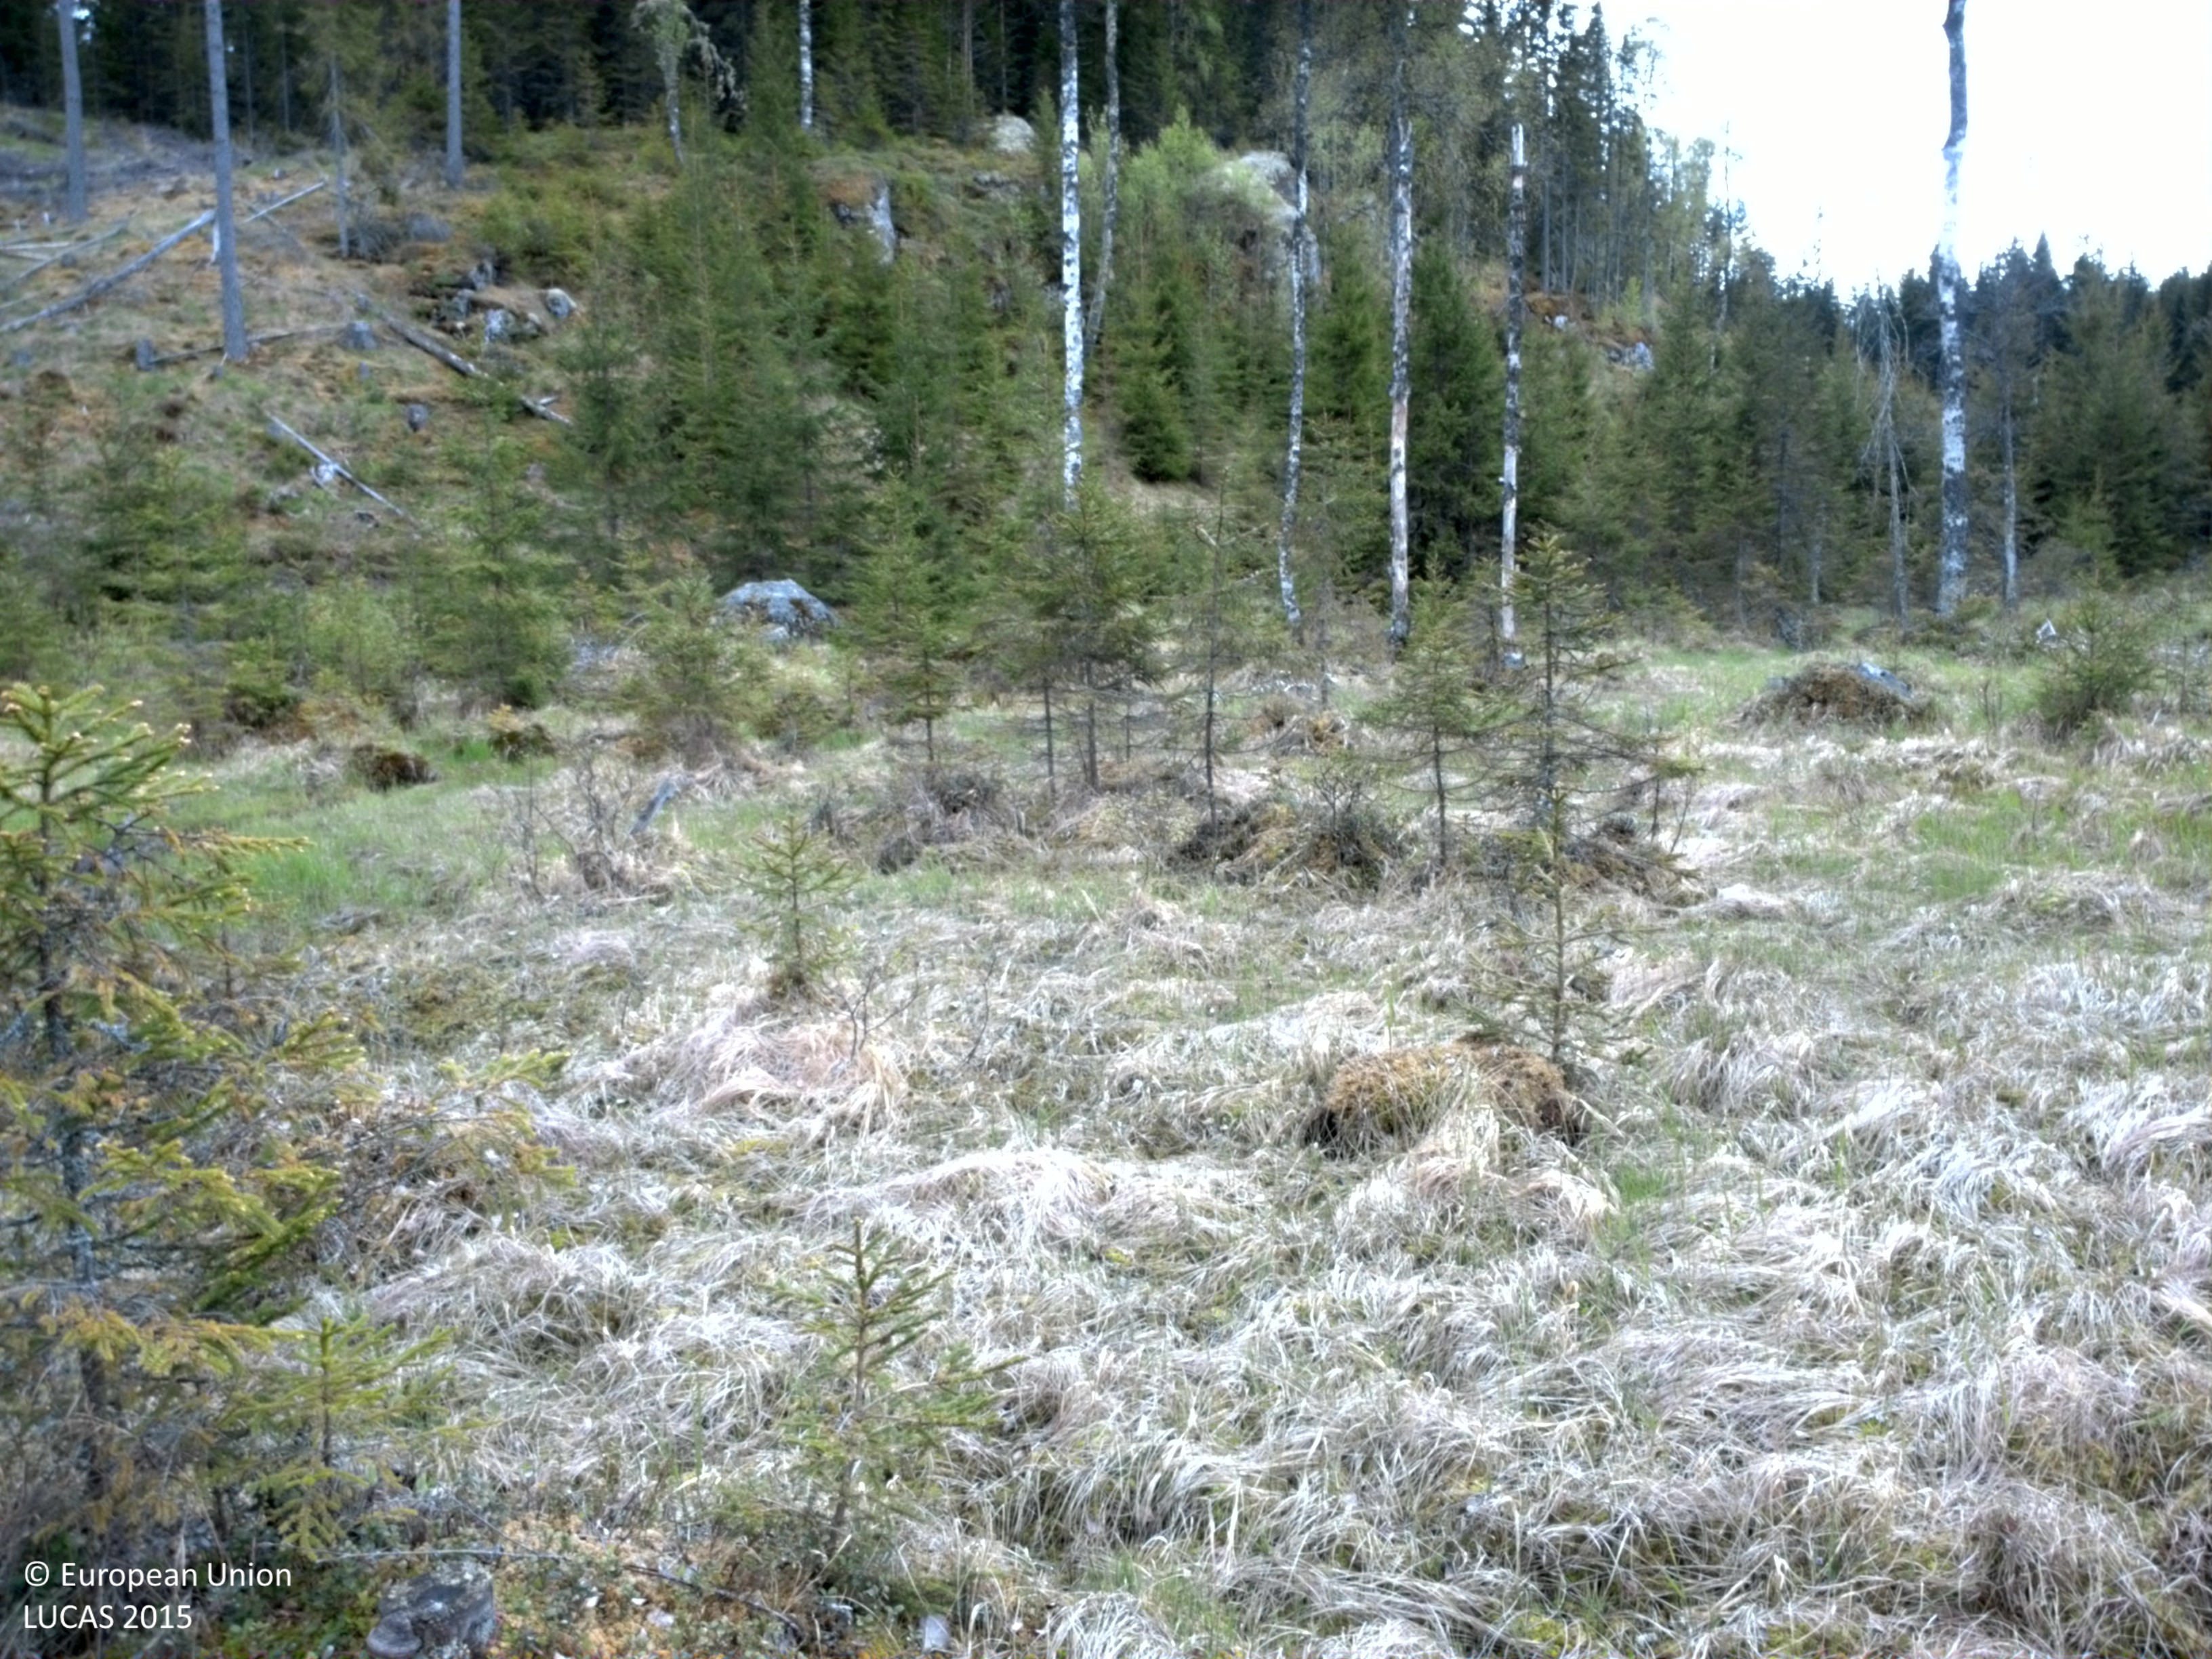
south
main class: Woodland
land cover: Spruce dominated coniferous woodland
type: boreal forest
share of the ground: 10 - 25 %
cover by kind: herbaceous plants 65 %, coniferous forest trees 20 %, shrubs 15 %
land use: Forestry
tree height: < 5 m
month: May
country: SE
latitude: 59.6394
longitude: 12.3174
